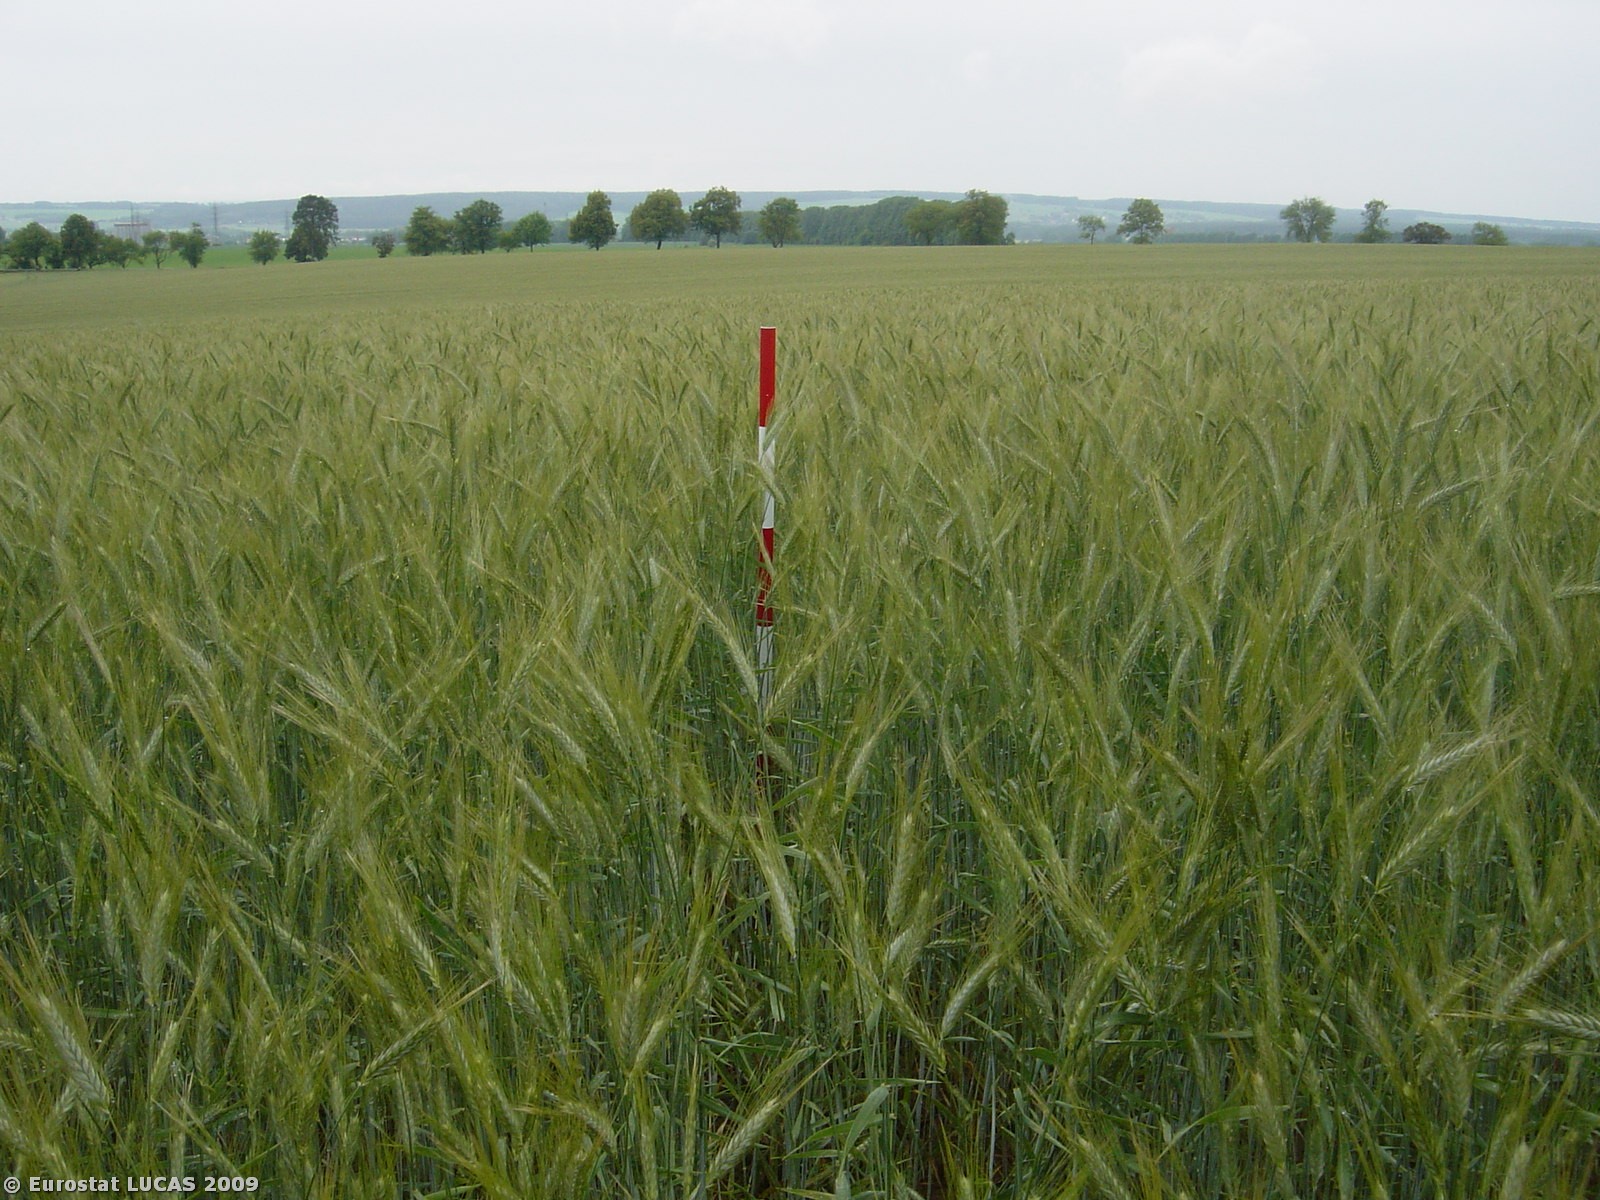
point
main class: Cropland
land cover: Triticale
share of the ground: > 75 %
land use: Agriculture (excluding fallow land and kitchen gardens)
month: June
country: CZ
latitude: 49.7631
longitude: 16.5185
